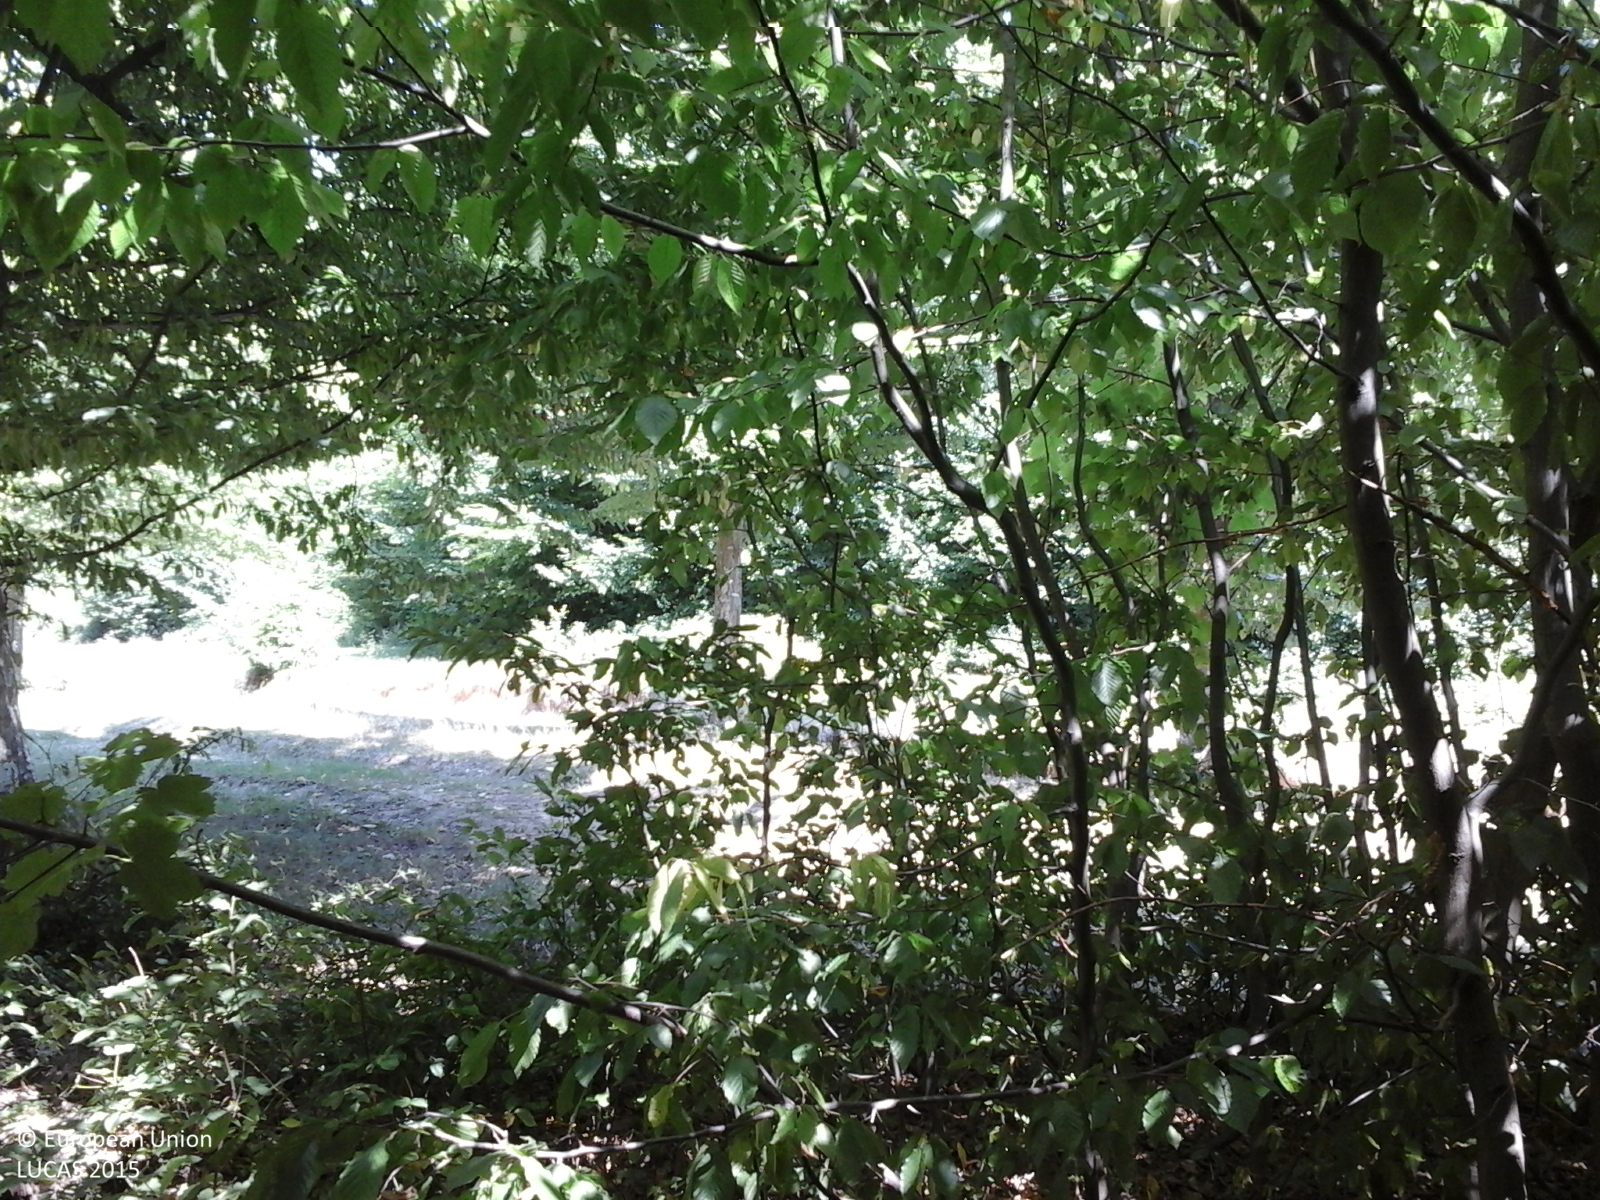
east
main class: Woodland
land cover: Broadleaved woodland
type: acidophilous oak and oak-birch forest
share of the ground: > 75 %
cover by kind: broadleaved forest trees 100 %
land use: Forestry
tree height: > 5 m
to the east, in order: Broadleaved woodland; Tracks; Broadleaved woodland; Tracks; Rocks and stones; Broadleaved woodland
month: July
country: RO
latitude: 44.9066
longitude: 24.4487
